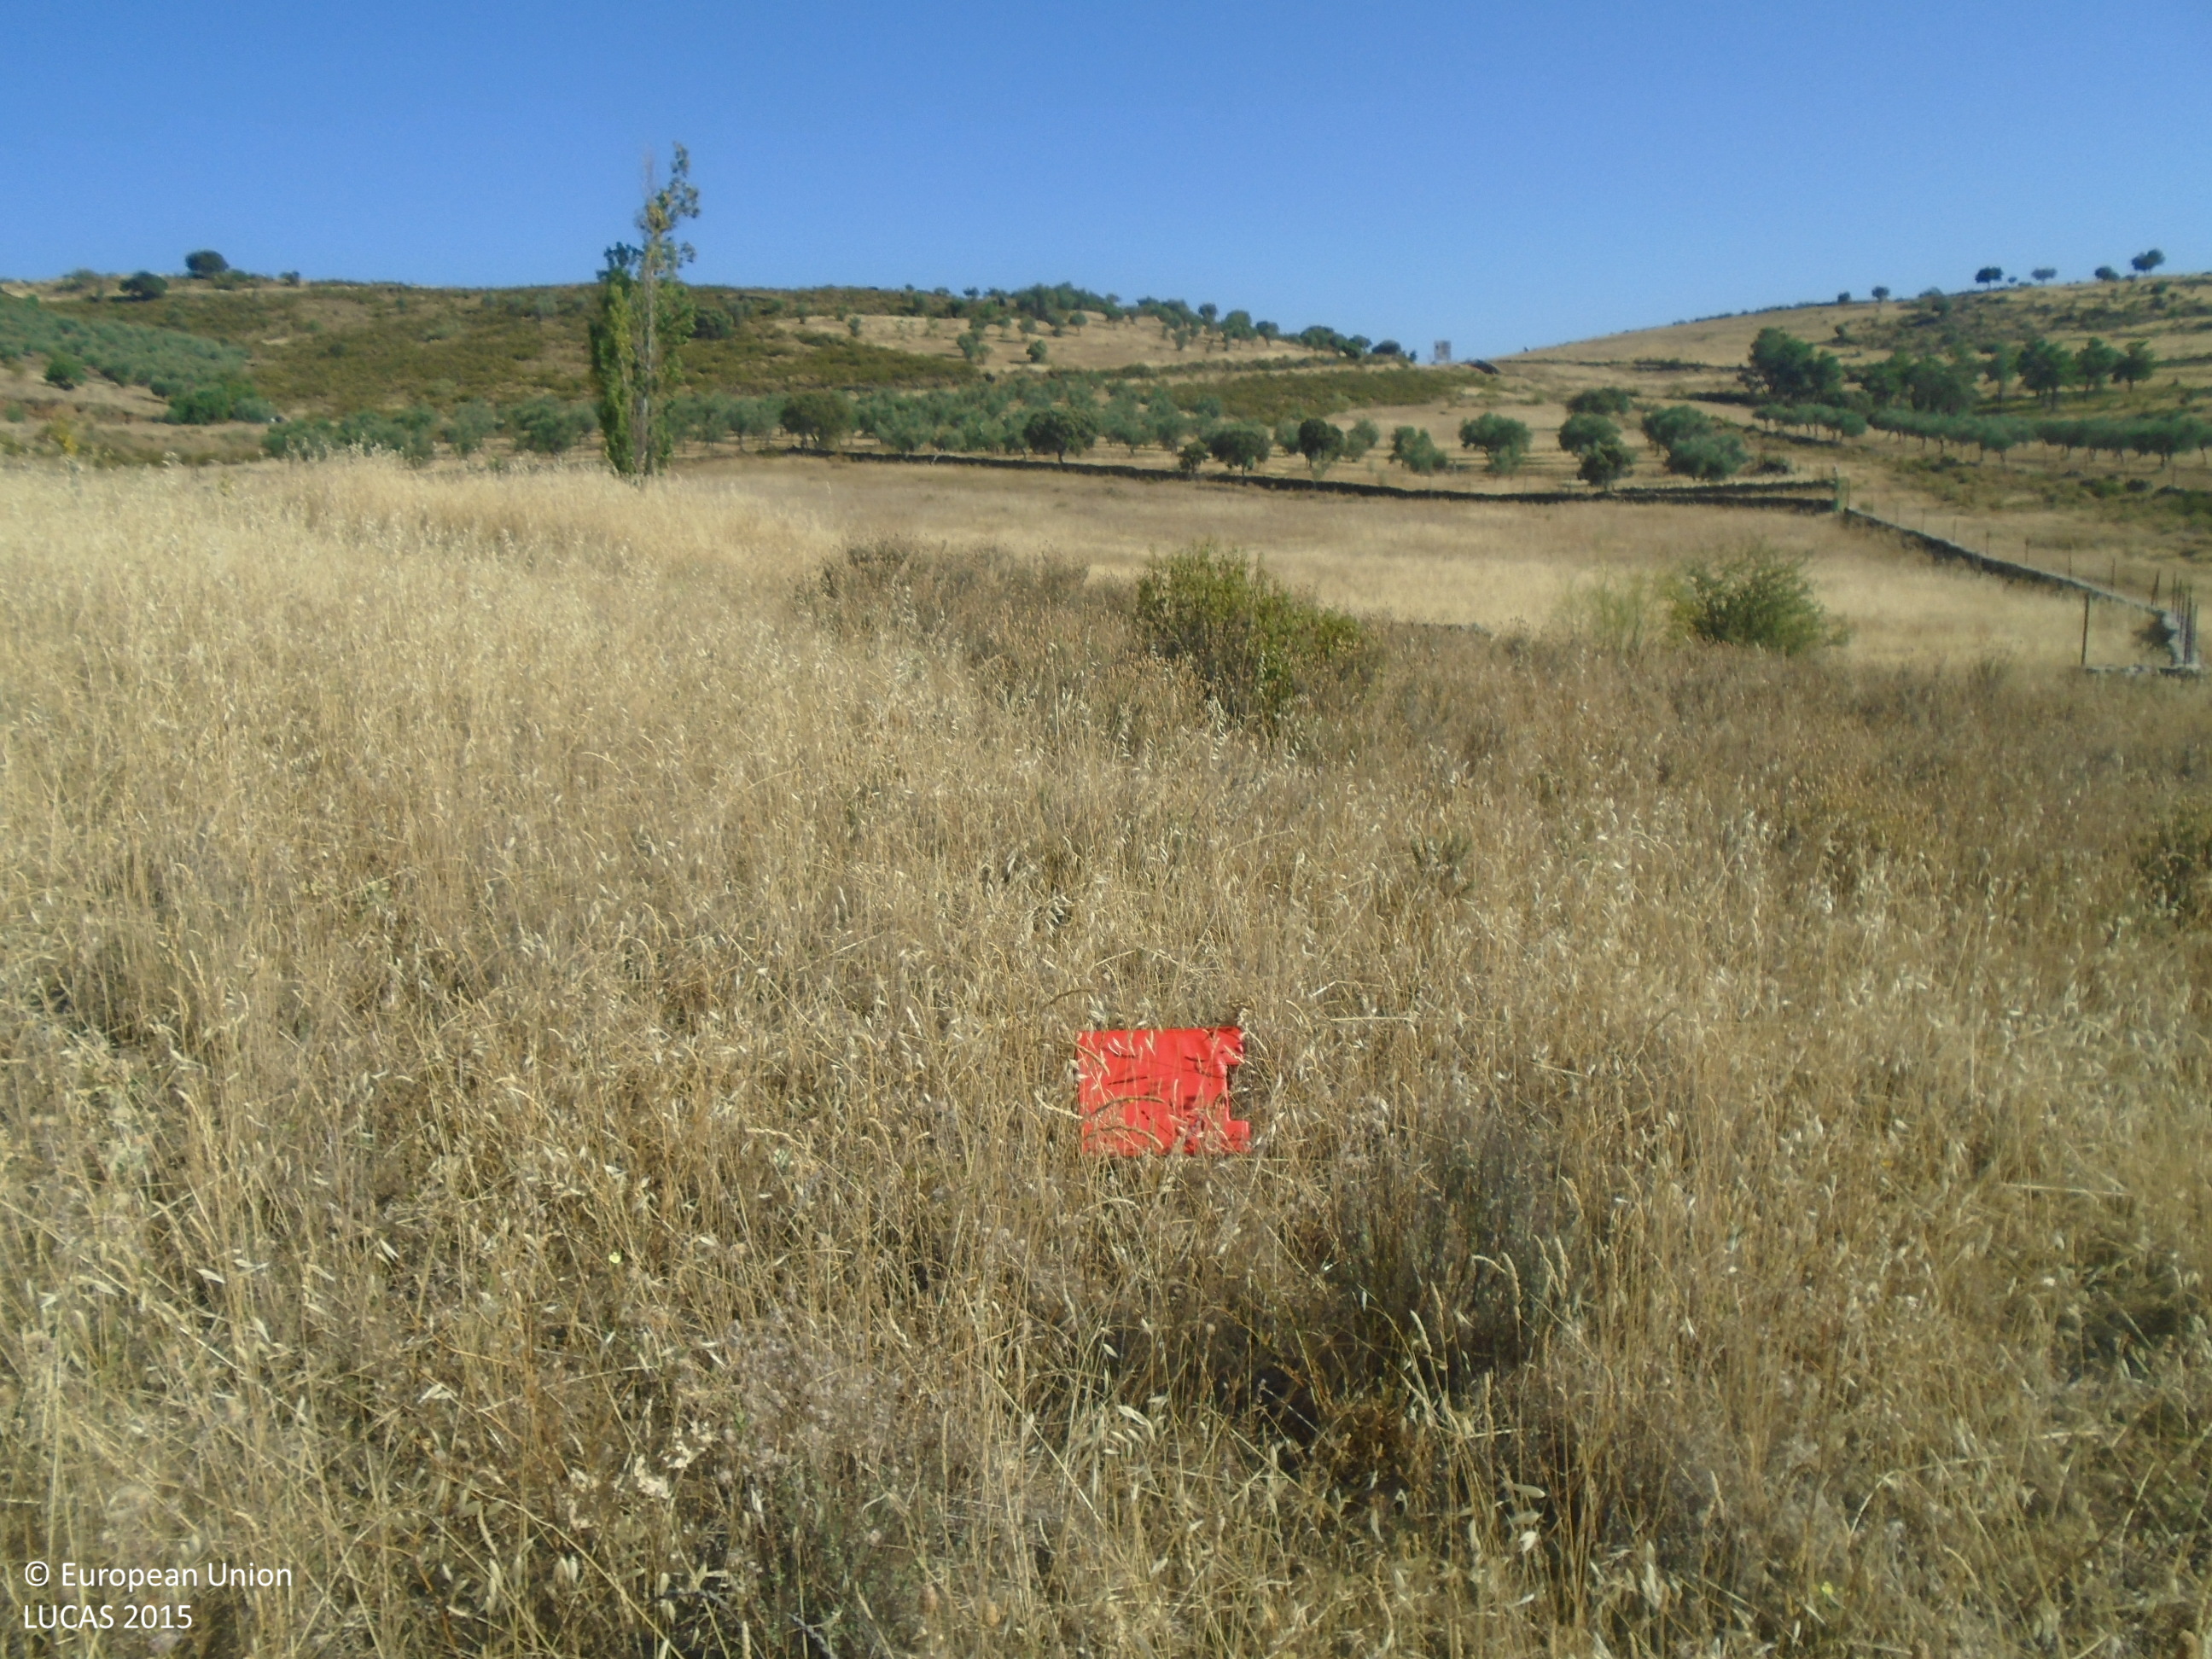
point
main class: Grassland
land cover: Grassland without tree/shrub cover
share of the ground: > 75 %
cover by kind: herbaceous plants 100 %
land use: Agriculture (excluding fallow land and kitchen gardens)
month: July
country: ES
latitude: 39.5763
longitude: -5.0517
